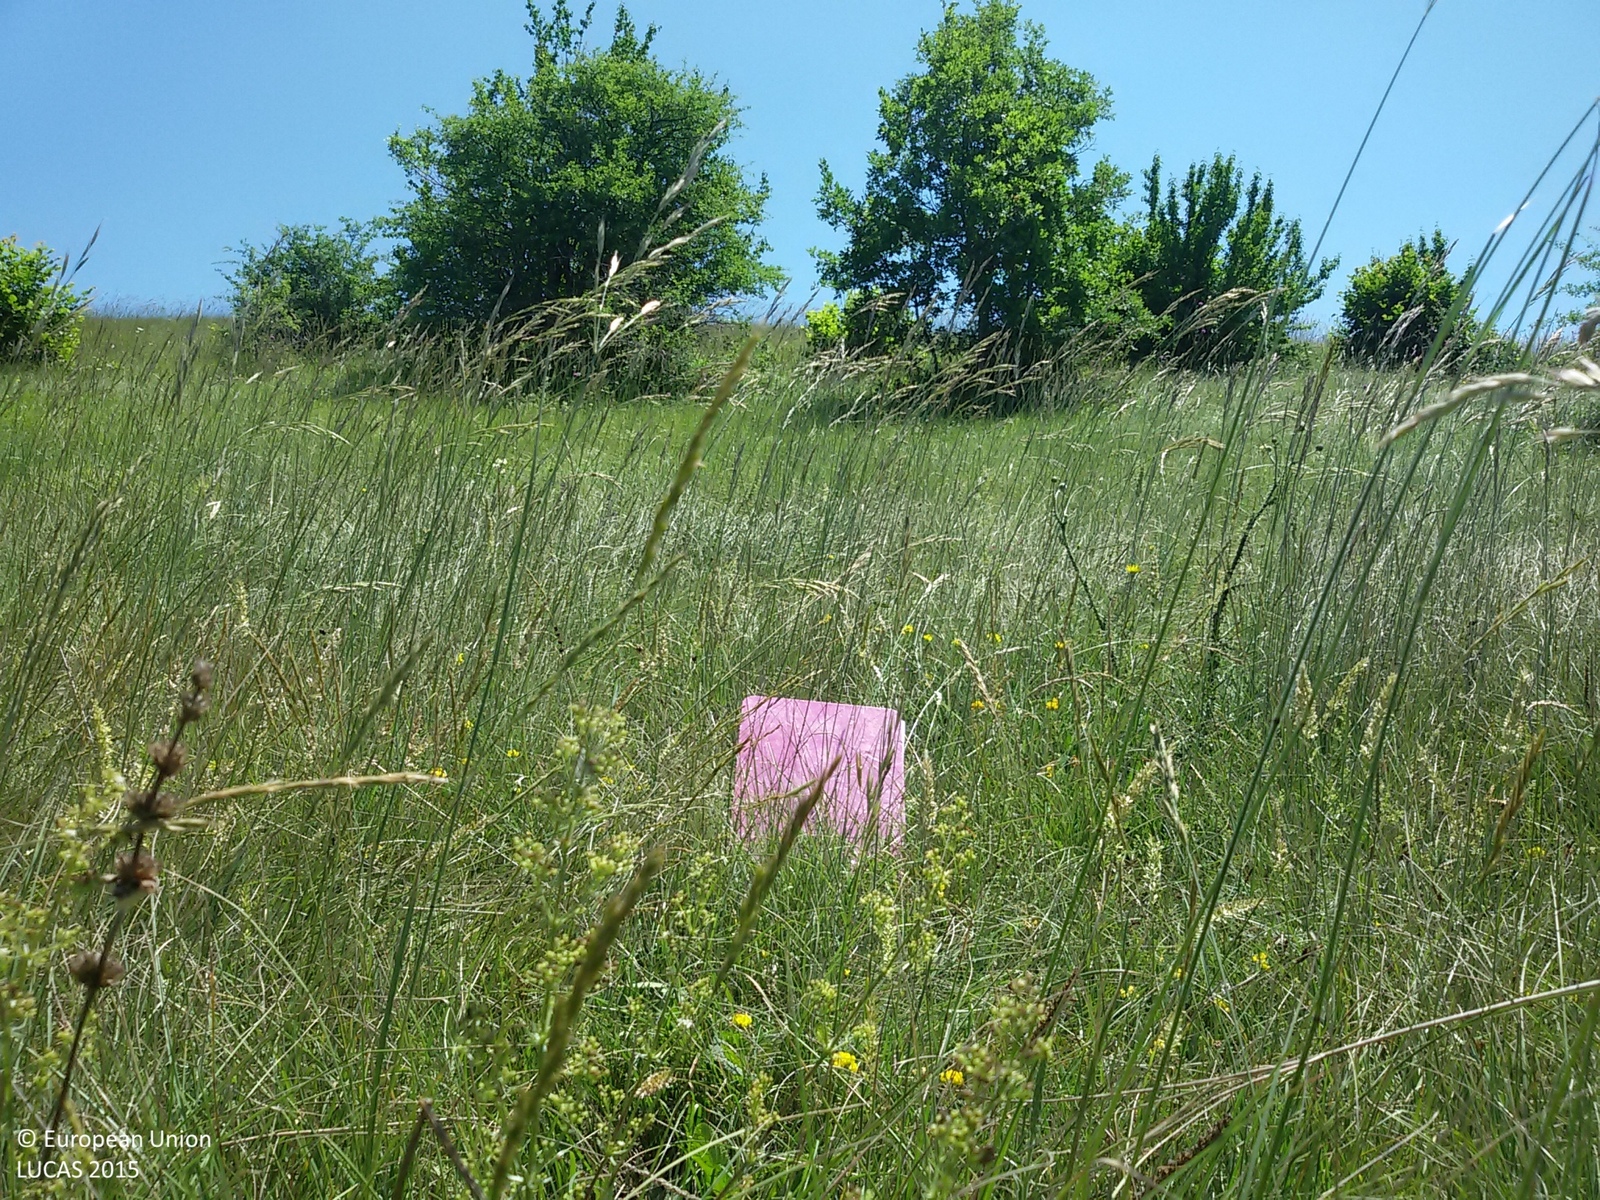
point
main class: Woodland
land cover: Broadleaved woodland
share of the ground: 10 - 25 %
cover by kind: herbaceous plants 55 %, broadleaved forest trees 25 %, shrubs 15 %, unconsolidated bare surface 5 %
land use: Semi-natural and natural areas not in use
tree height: < 5 m
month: June
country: HR
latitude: 44.4989
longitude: 15.7411
